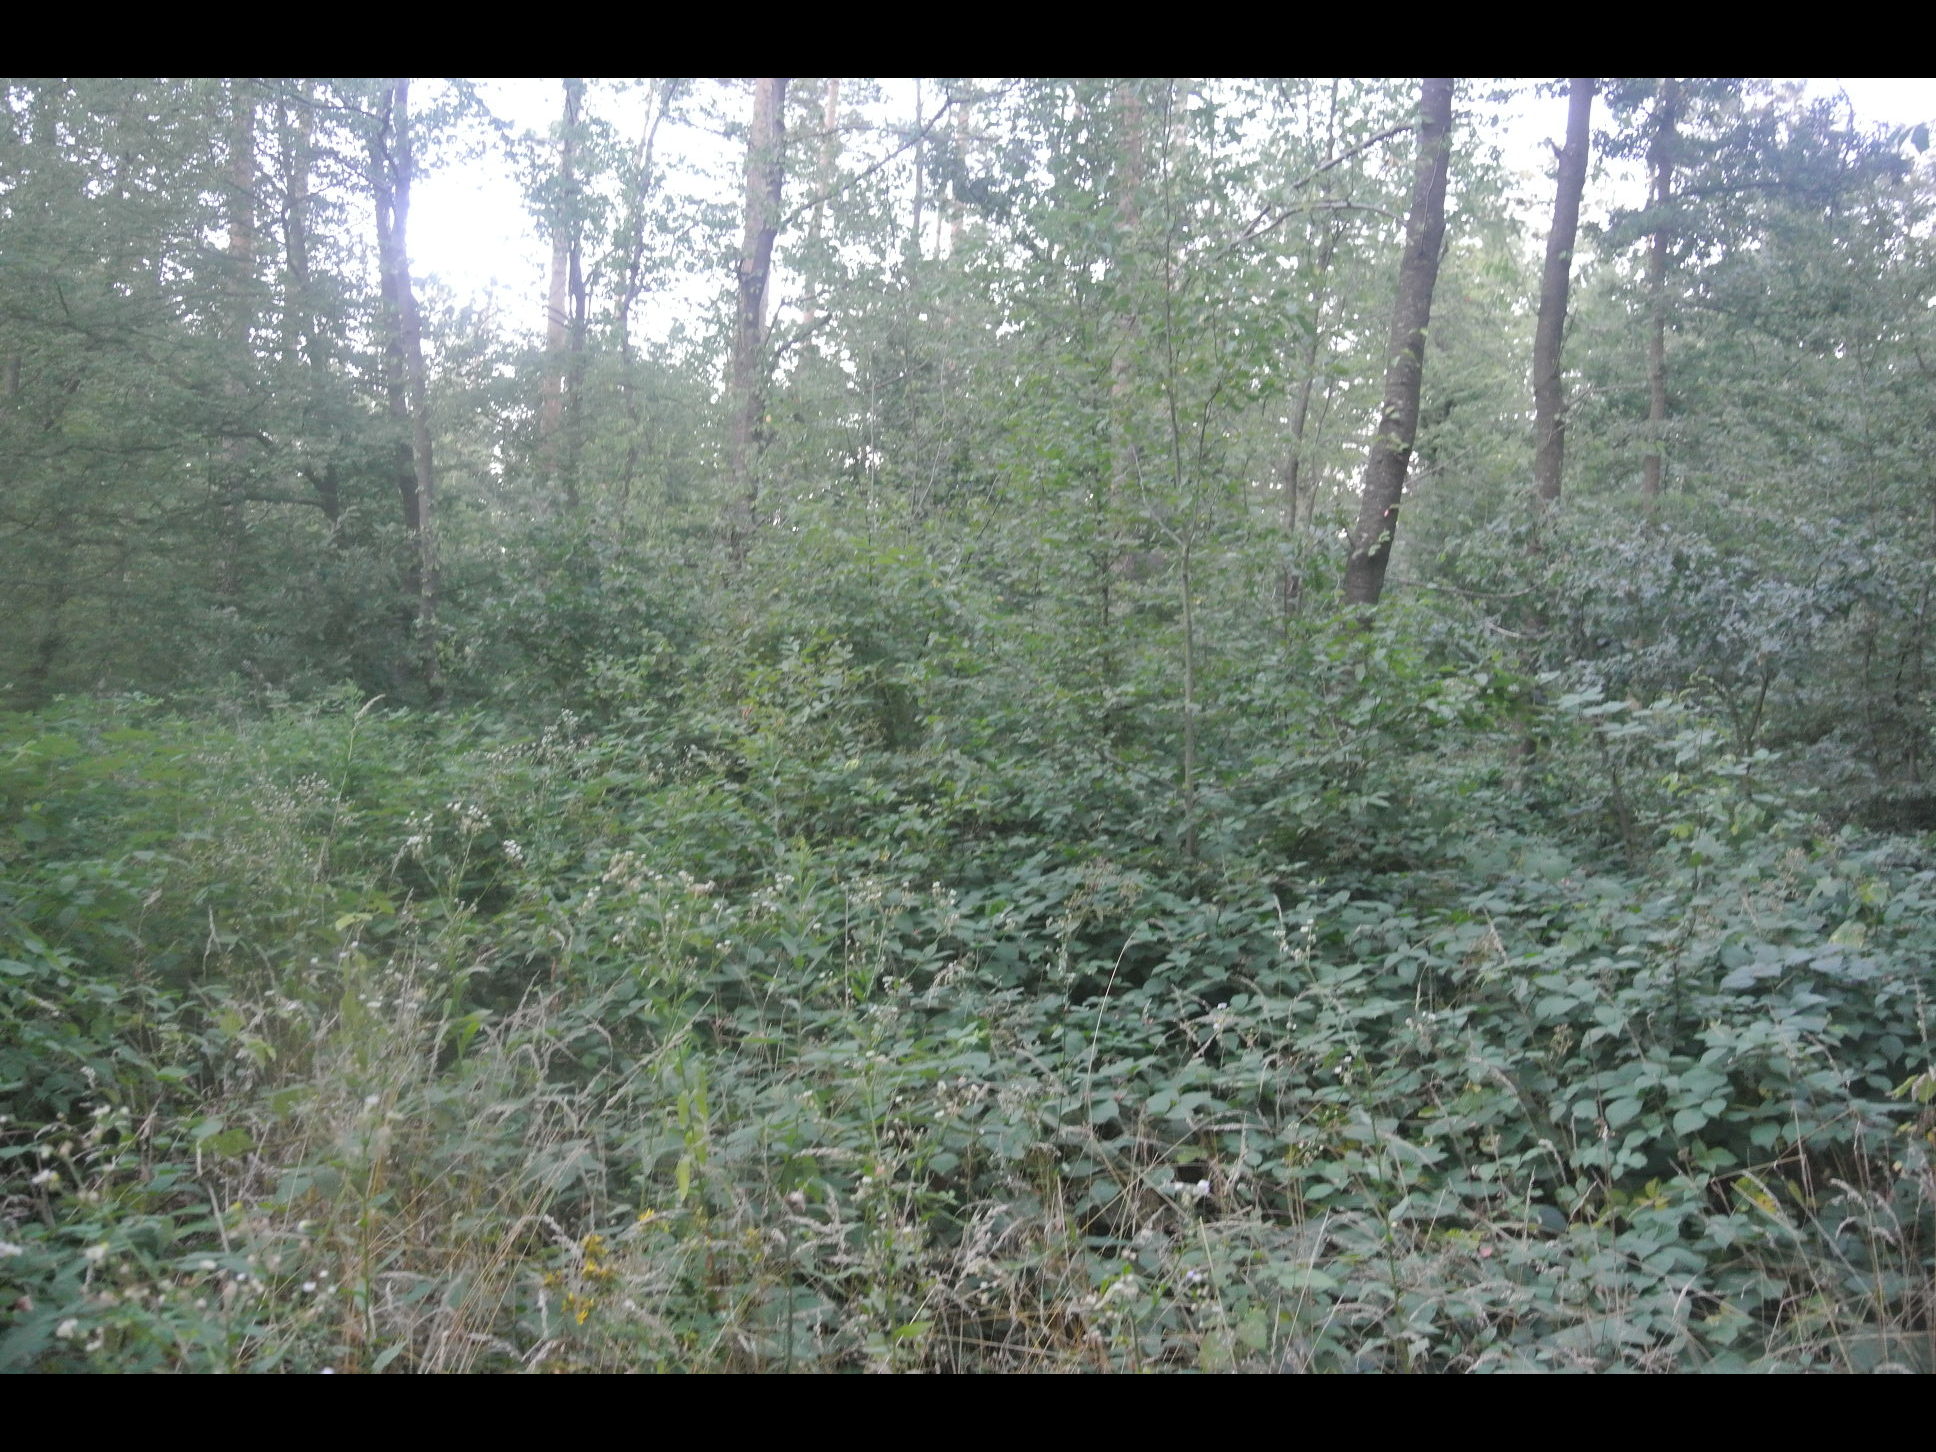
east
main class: Woodland
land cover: Pine dominated mixed woodland
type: alpine coniferous forest
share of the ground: > 75 %
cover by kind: broadleaved forest trees 75 %, coniferous forest trees 25 %
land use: Forestry
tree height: > 5 m
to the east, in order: Pine dominated mixed woodland; Tracks; Pine dominated mixed woodland; Tracks; Pine dominated mixed woodland; Grassland without tree/shrub cover; Pine dominated mixed woodland
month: July
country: AT
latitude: 47.5832
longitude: 16.4525
